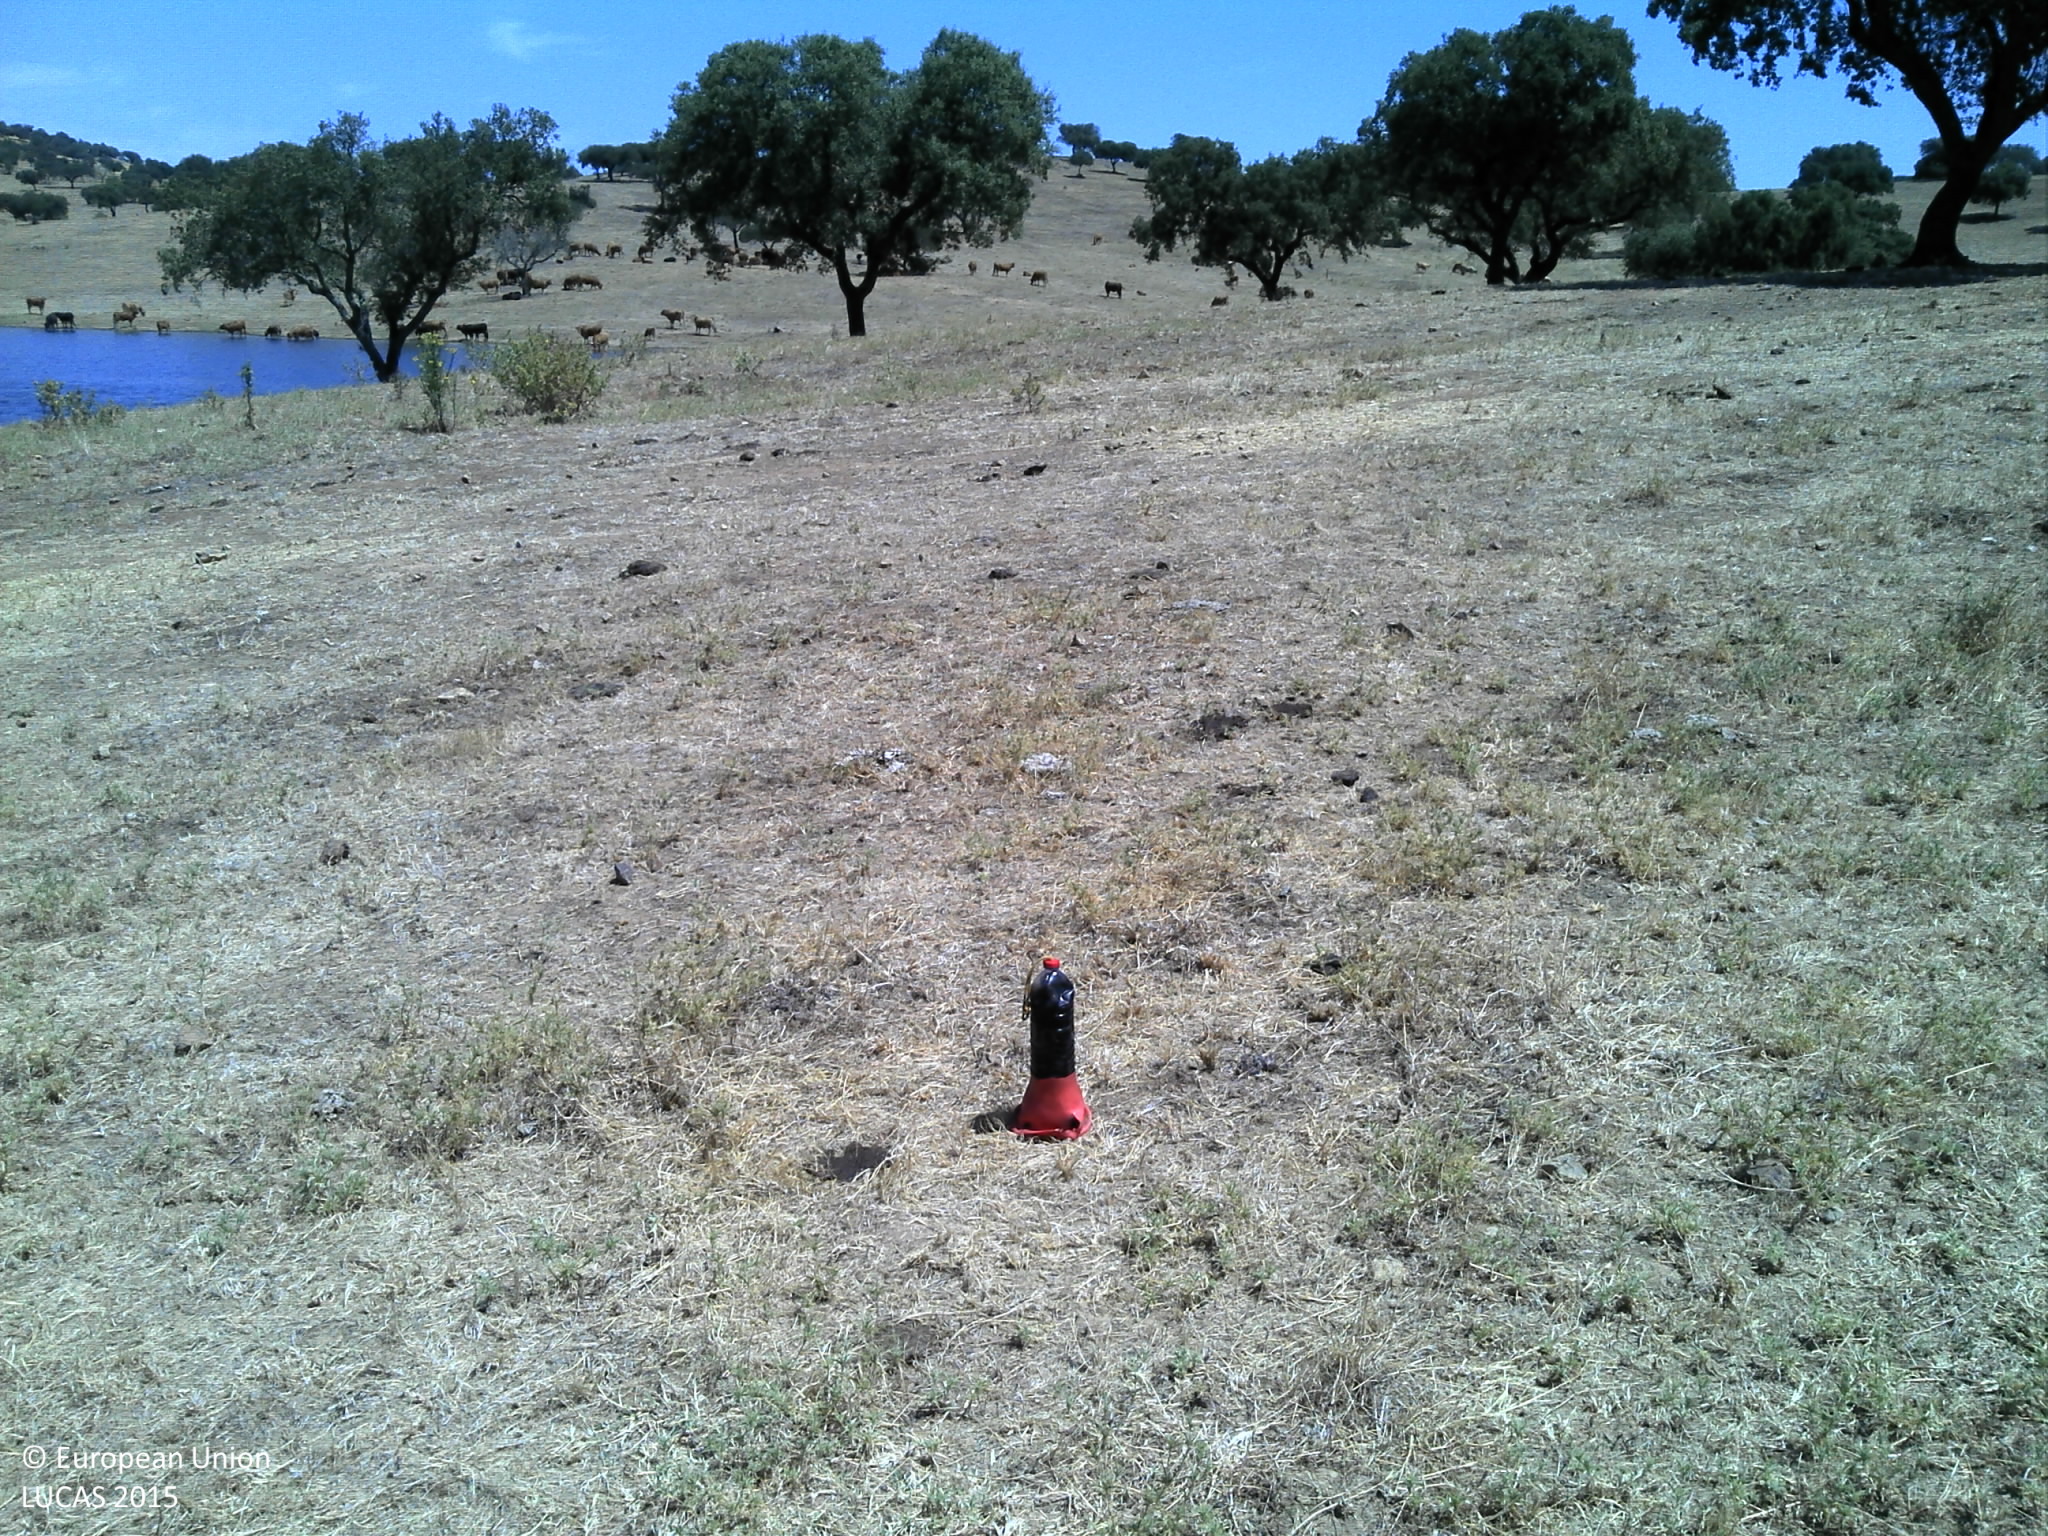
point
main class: Grassland
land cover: Grassland without tree/shrub cover
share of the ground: < 10 %
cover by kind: unconsolidated bare surface 90 %, herbaceous plants 10 %
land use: Agriculture (excluding fallow land and kitchen gardens)
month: June
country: PT
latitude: 38.2659
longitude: -8.1318
